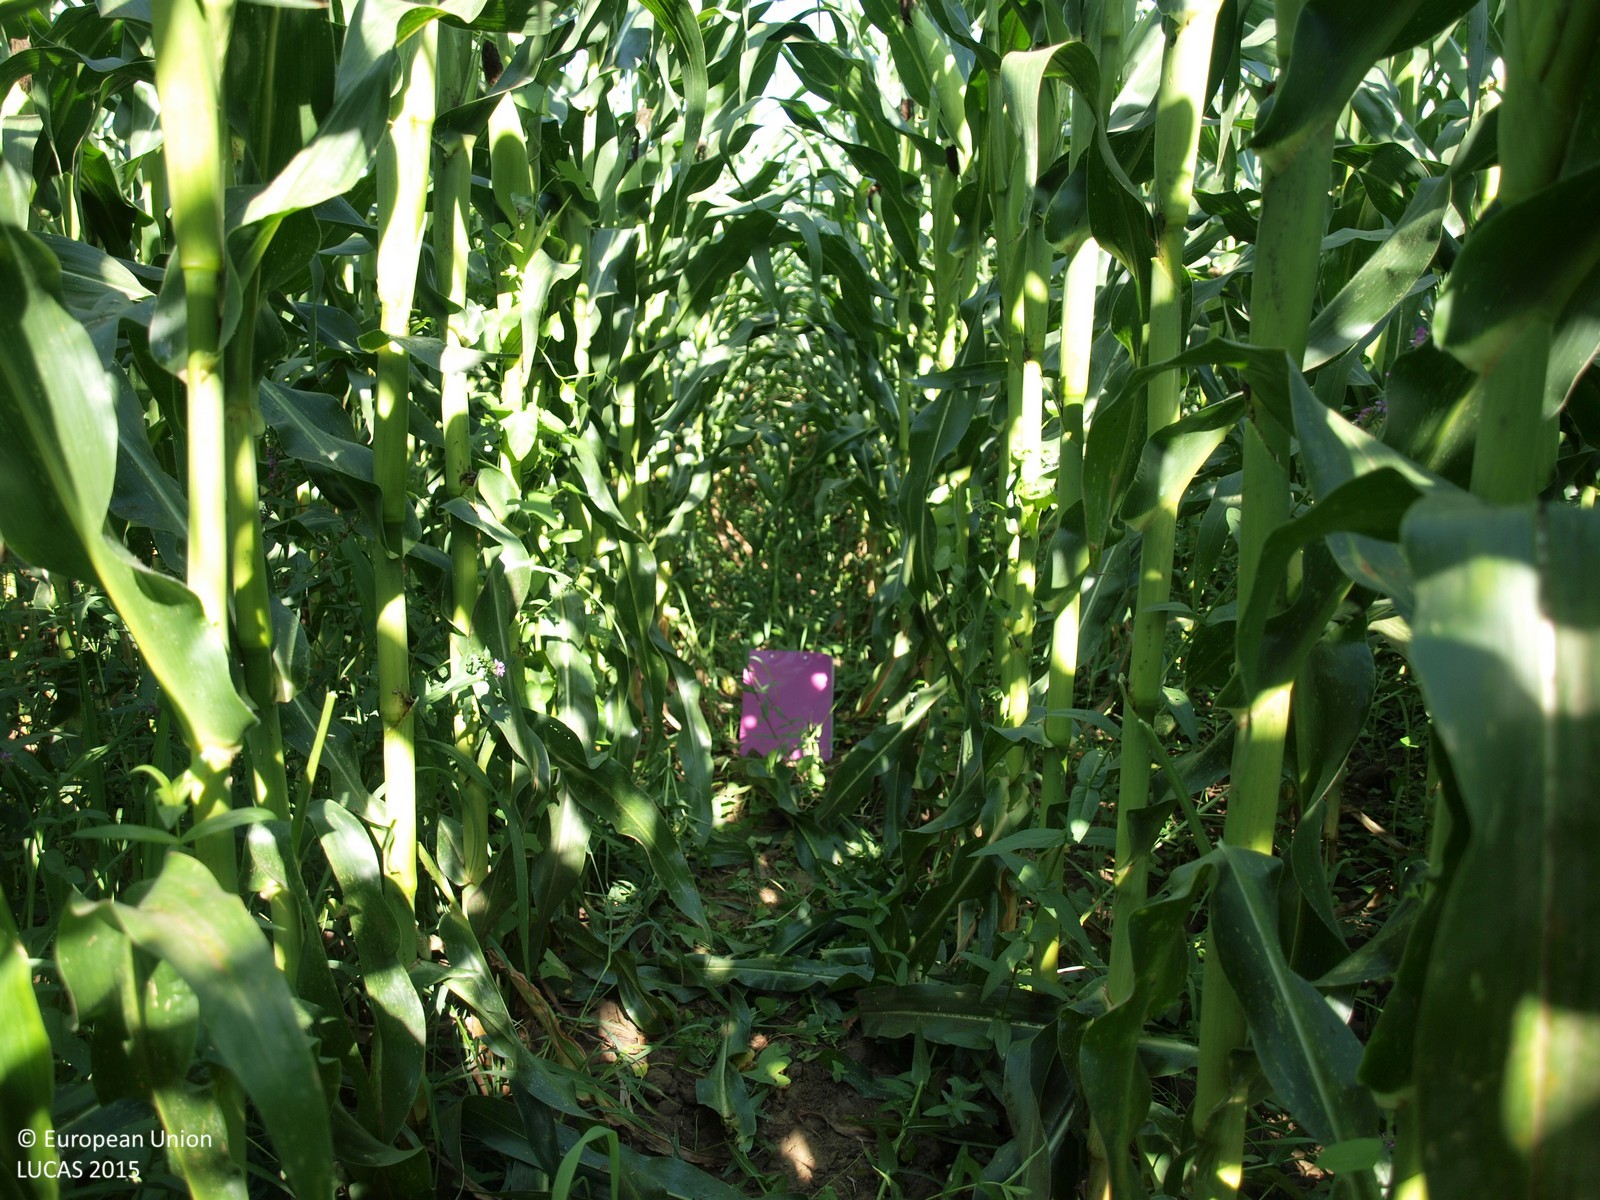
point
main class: Cropland
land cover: Maize
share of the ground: > 75 %
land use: Agriculture (excluding fallow land and kitchen gardens)
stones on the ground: < 10 %
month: August
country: HR
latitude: 46.0036
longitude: 16.2879
